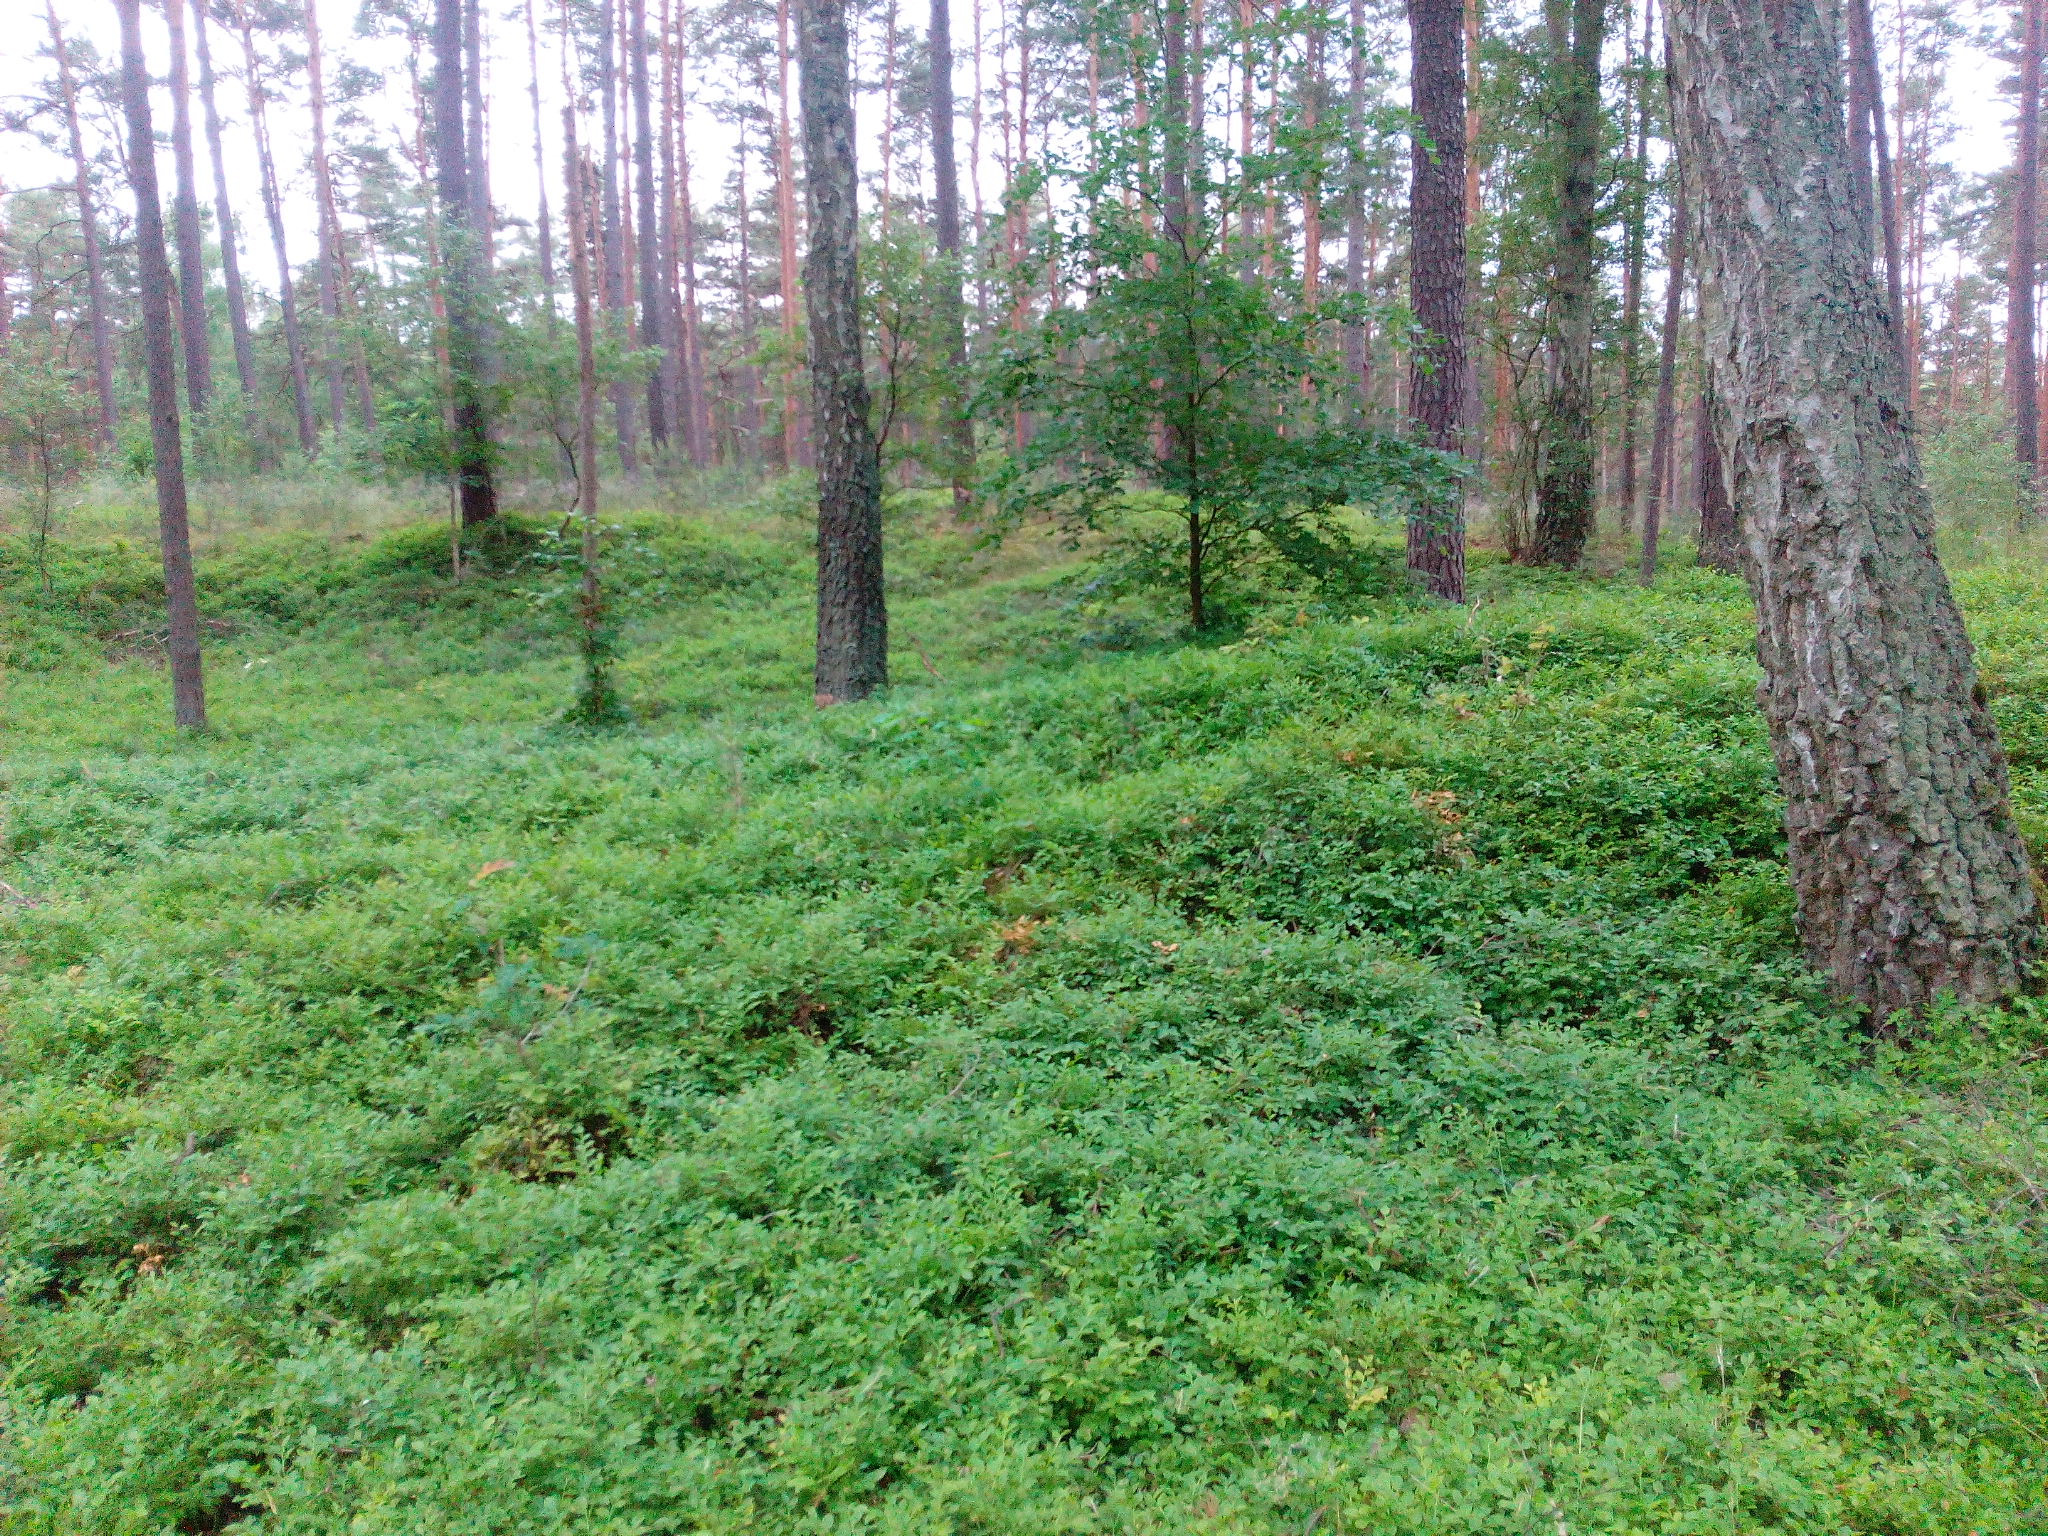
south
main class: Woodland
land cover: Pine dominated coniferous woodland
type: hemiboreal forest and nemoral coniferous forest and mixed broadleaved-coniferous forest
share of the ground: 50 - 75 %
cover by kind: coniferous forest trees 55 %, herbaceous plants 40 %, lichens and mosses 5 %
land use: Forestry
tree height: > 5 m
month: June
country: DE
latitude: 53.1981
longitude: 13.1882
